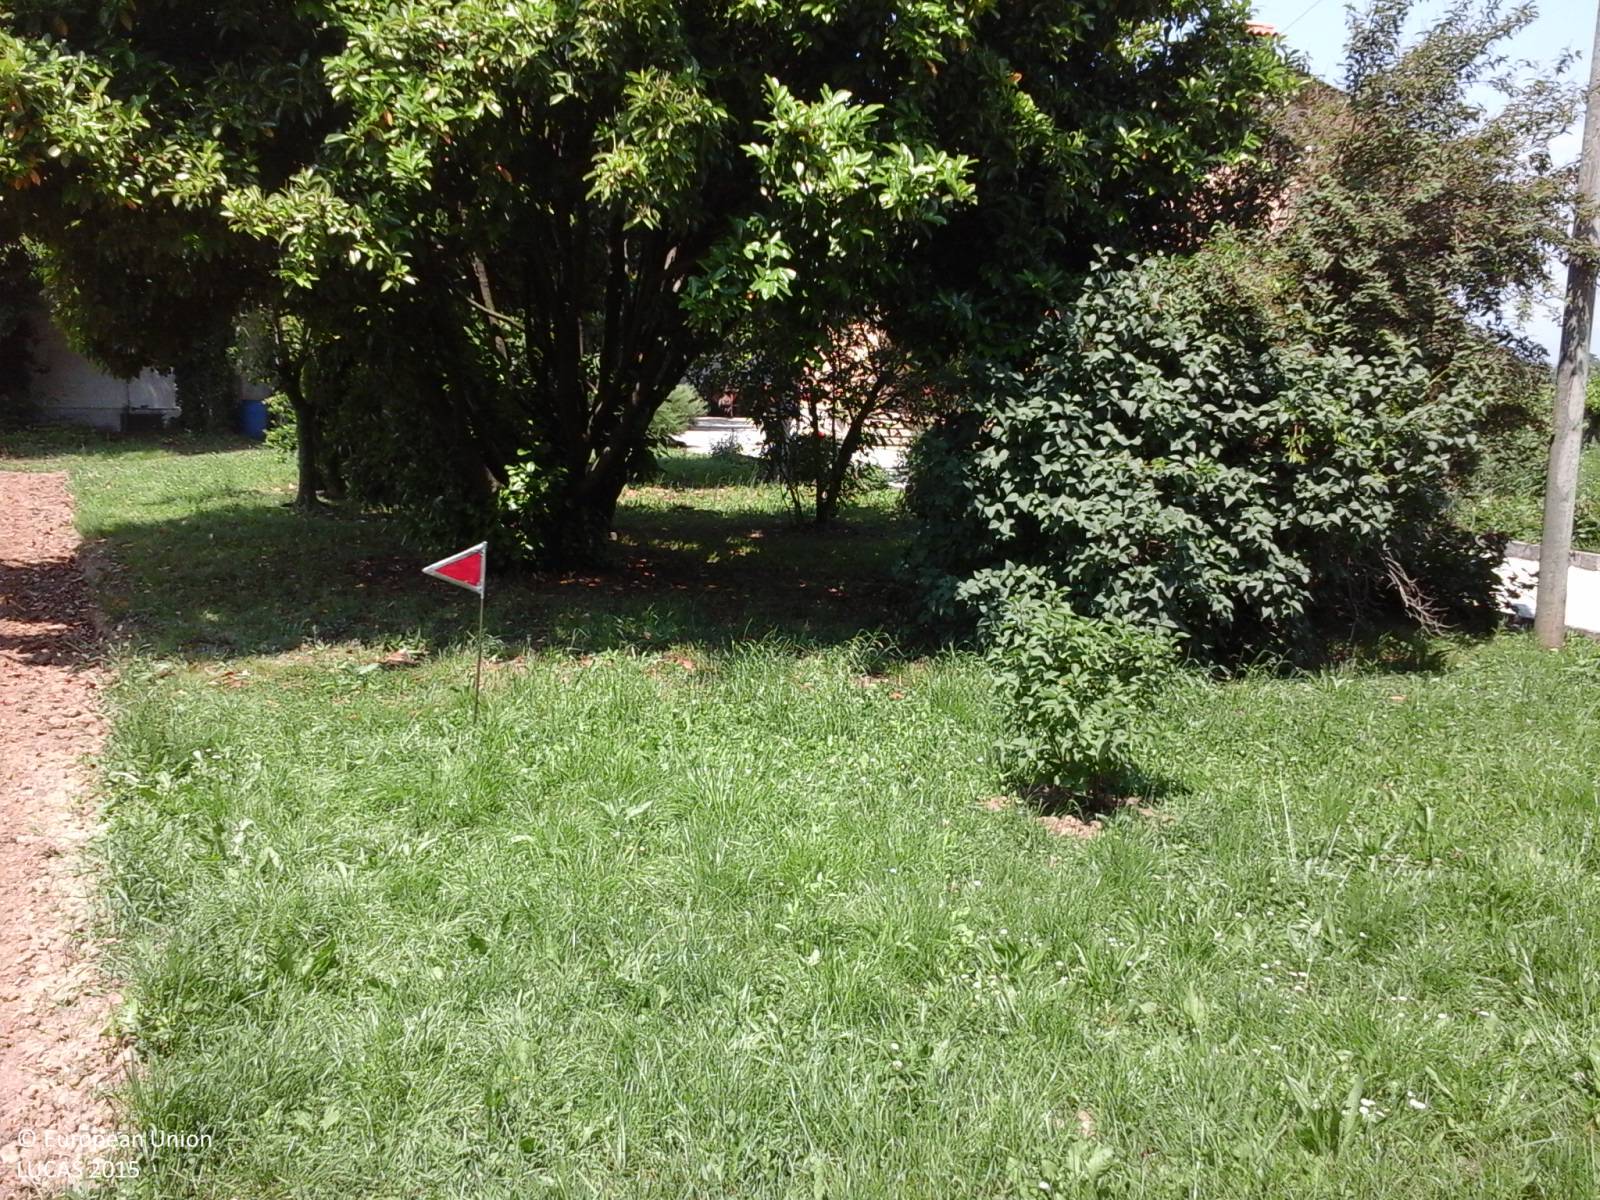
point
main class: Grassland
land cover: Grassland with sparse tree/shrub cover
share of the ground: > 75 %
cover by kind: herbaceous plants 90 %, broadleaved forest trees 5 %, shrubs 5 %
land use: Residential
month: June
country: IT
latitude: 45.9770
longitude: 13.2618
